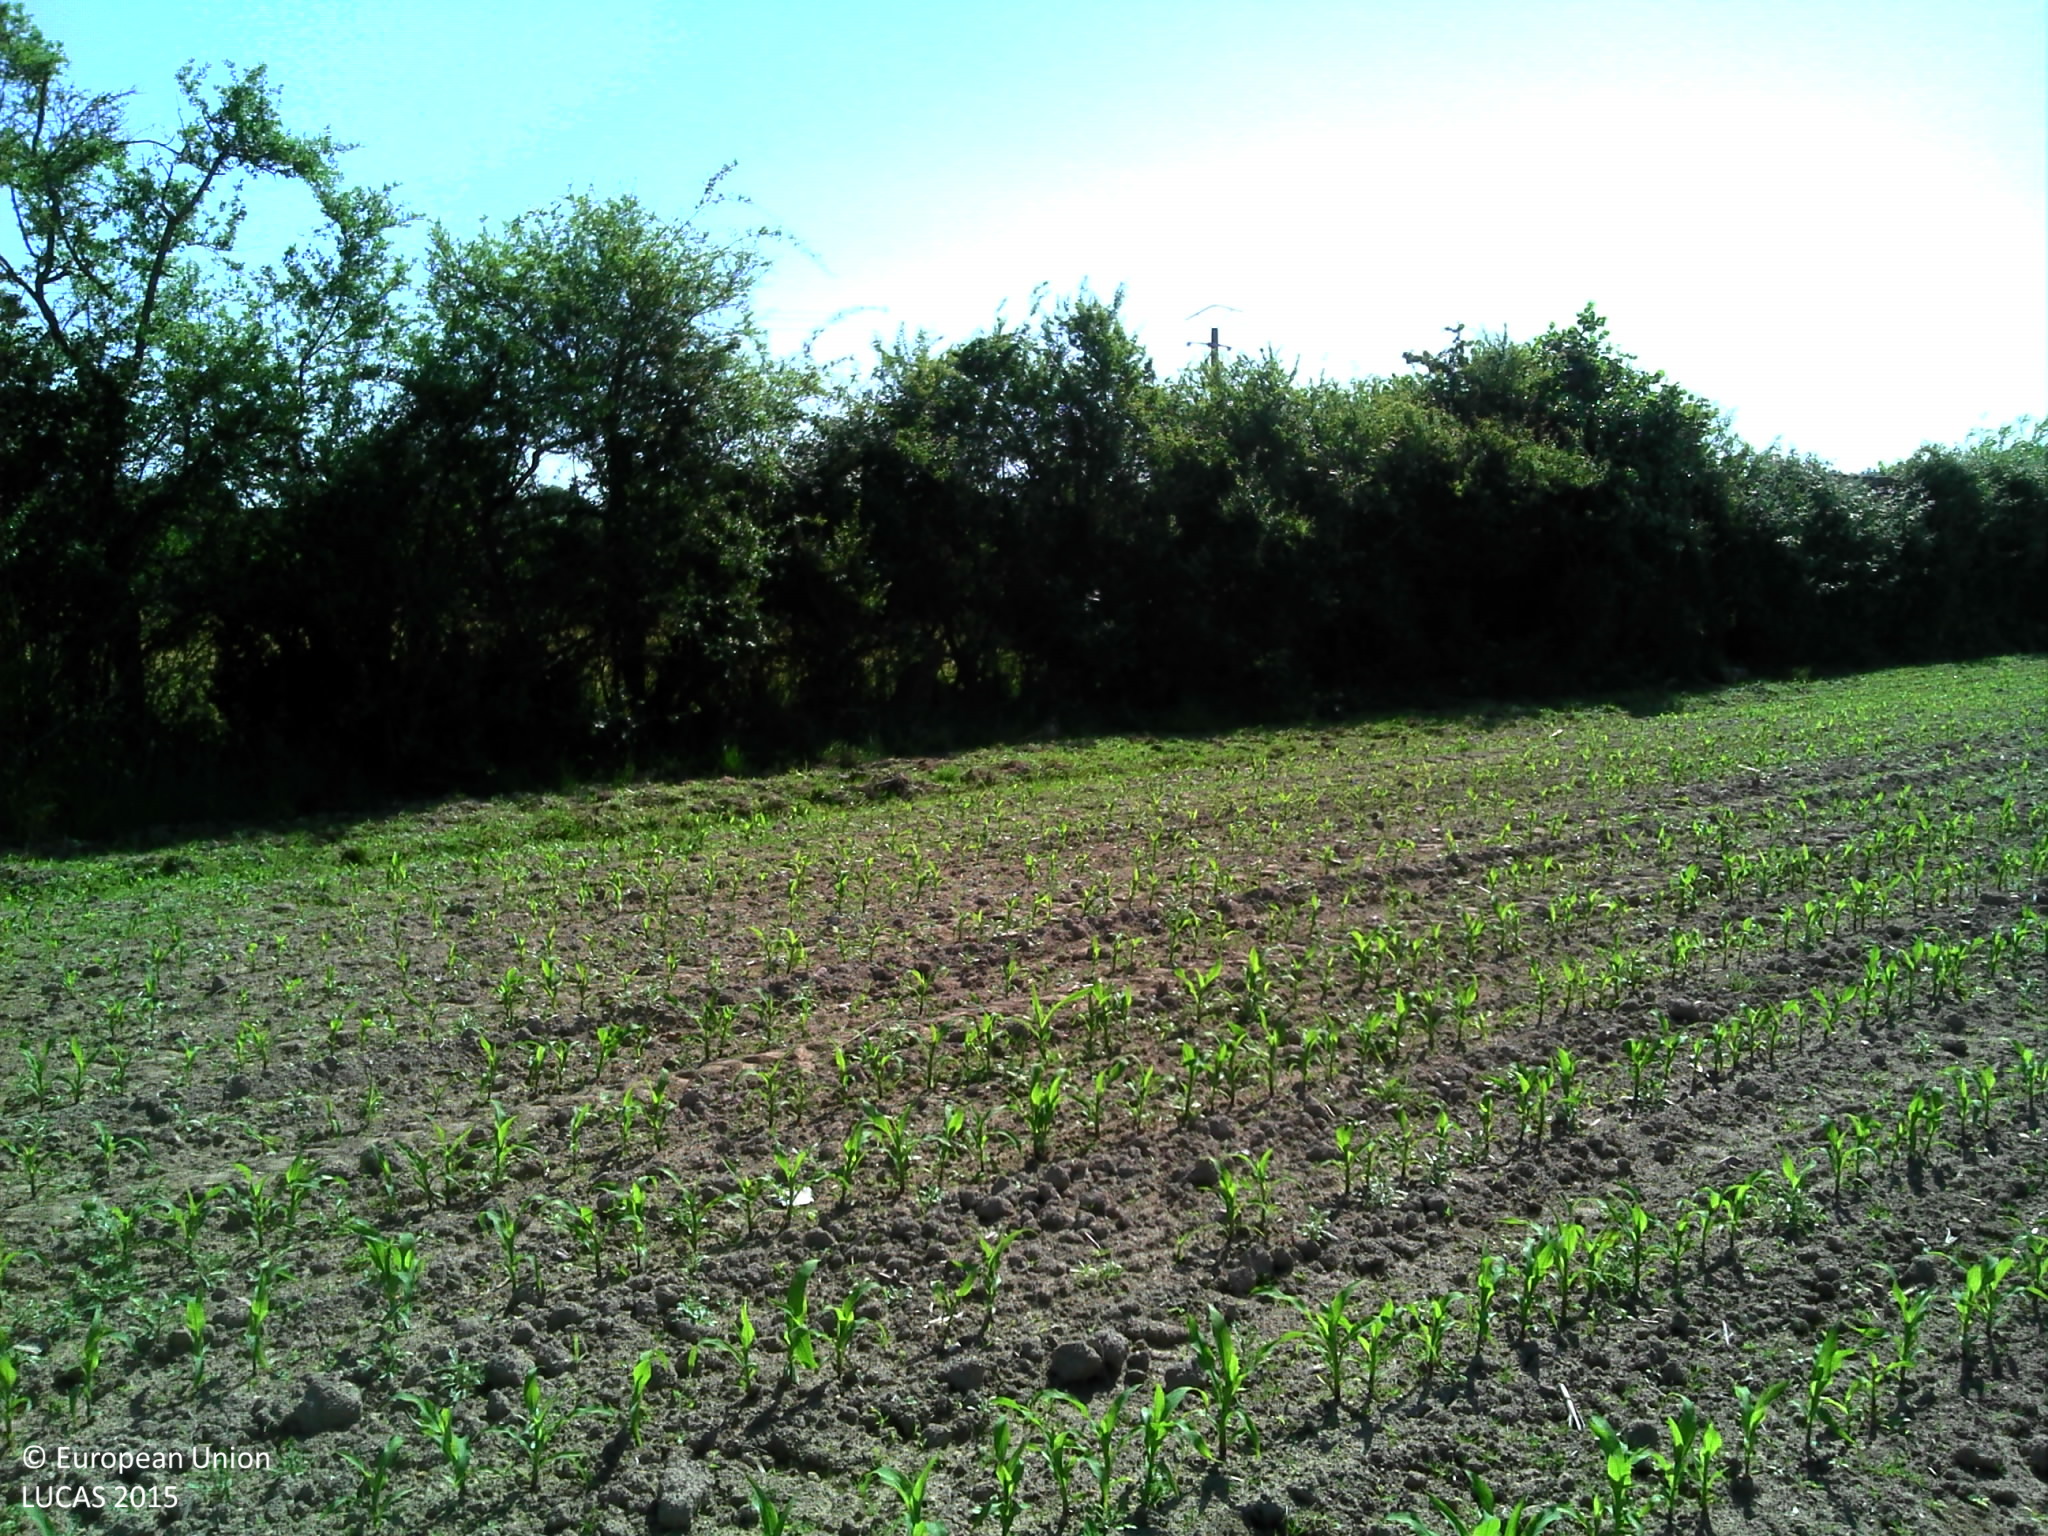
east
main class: Cropland
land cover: Maize
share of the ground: 10 - 25 %
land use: Agriculture (excluding fallow land and kitchen gardens)
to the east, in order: Maize; Managed hedges; Fences; Dry stone walls; Floriculture and ornamental plants; Electric lines; Floriculture and ornamental plants; Fences; Grassland without tree/shrub cover; Fences; Grassland without tree/shrub cover; Fences; Grassland without tree/shrub cover
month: June
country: FR
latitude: 47.0678
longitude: -1.2166
